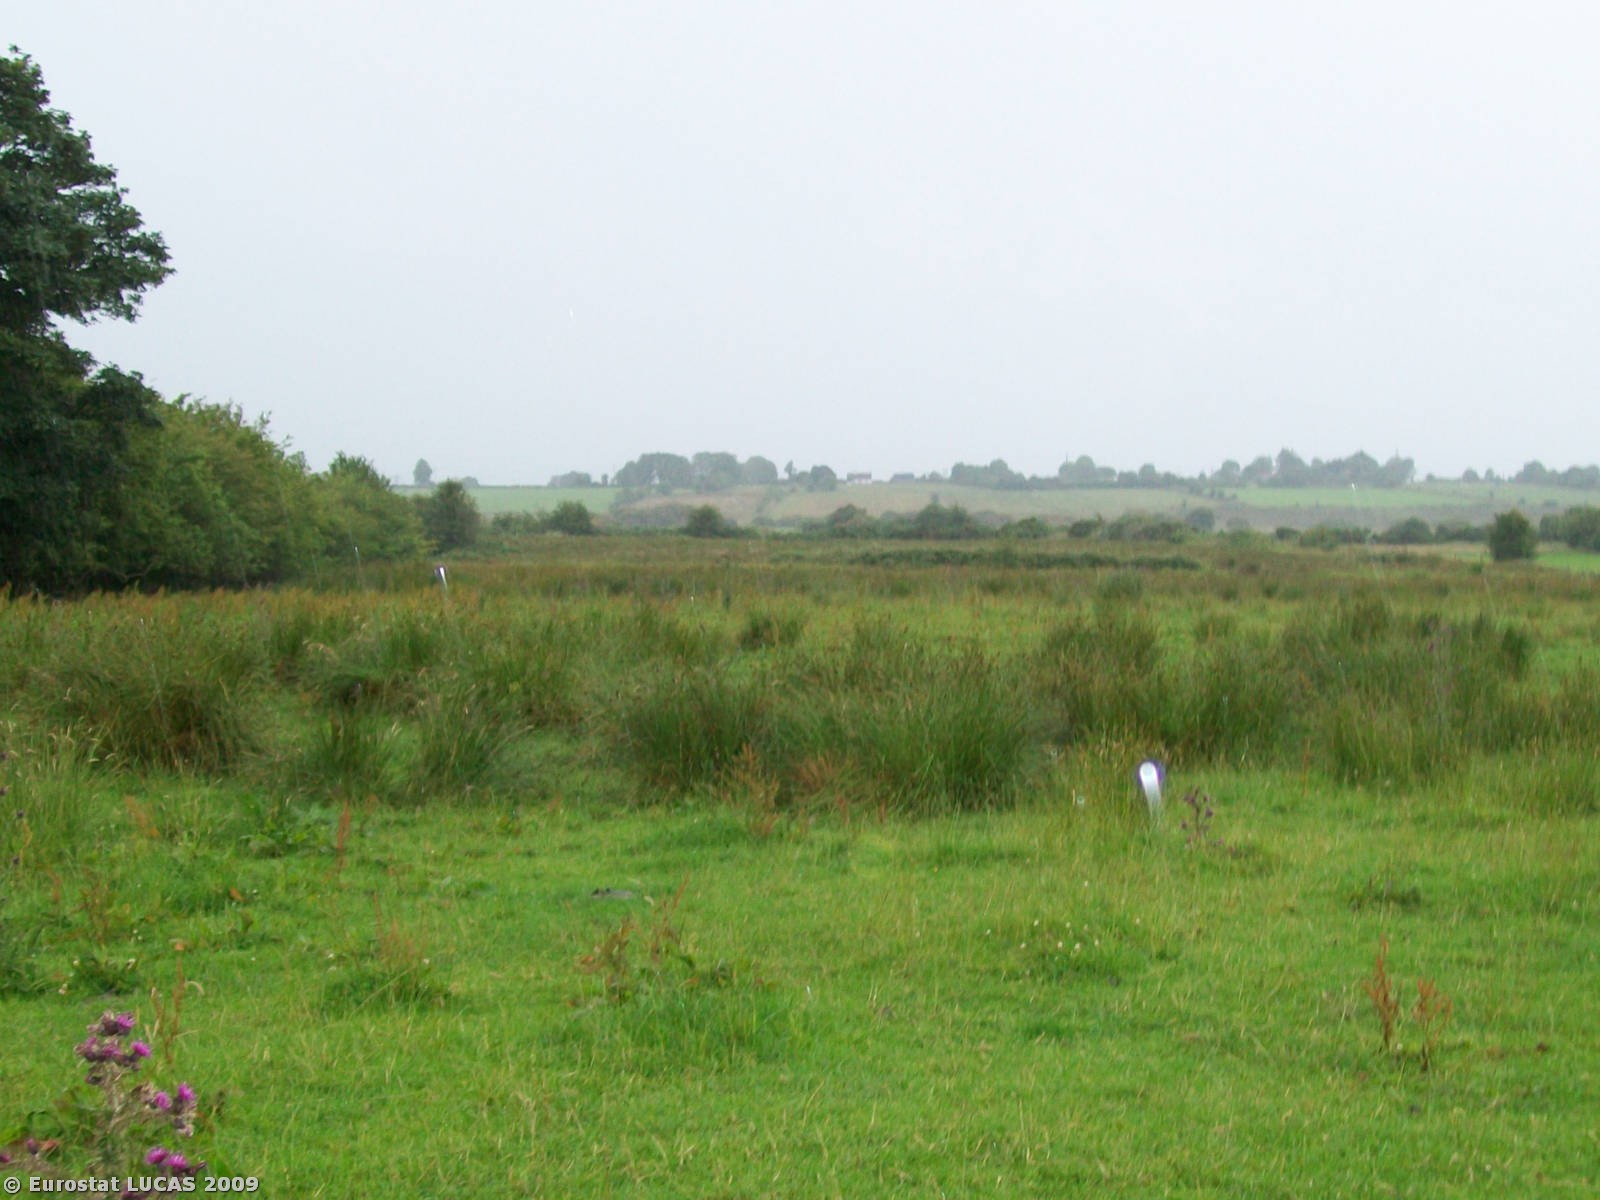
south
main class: Grassland
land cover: Grassland without tree/shrub cover
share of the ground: > 75 %
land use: Agriculture (excluding fallow land and kitchen gardens)
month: July
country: IE
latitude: 53.6255
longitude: -8.9439
